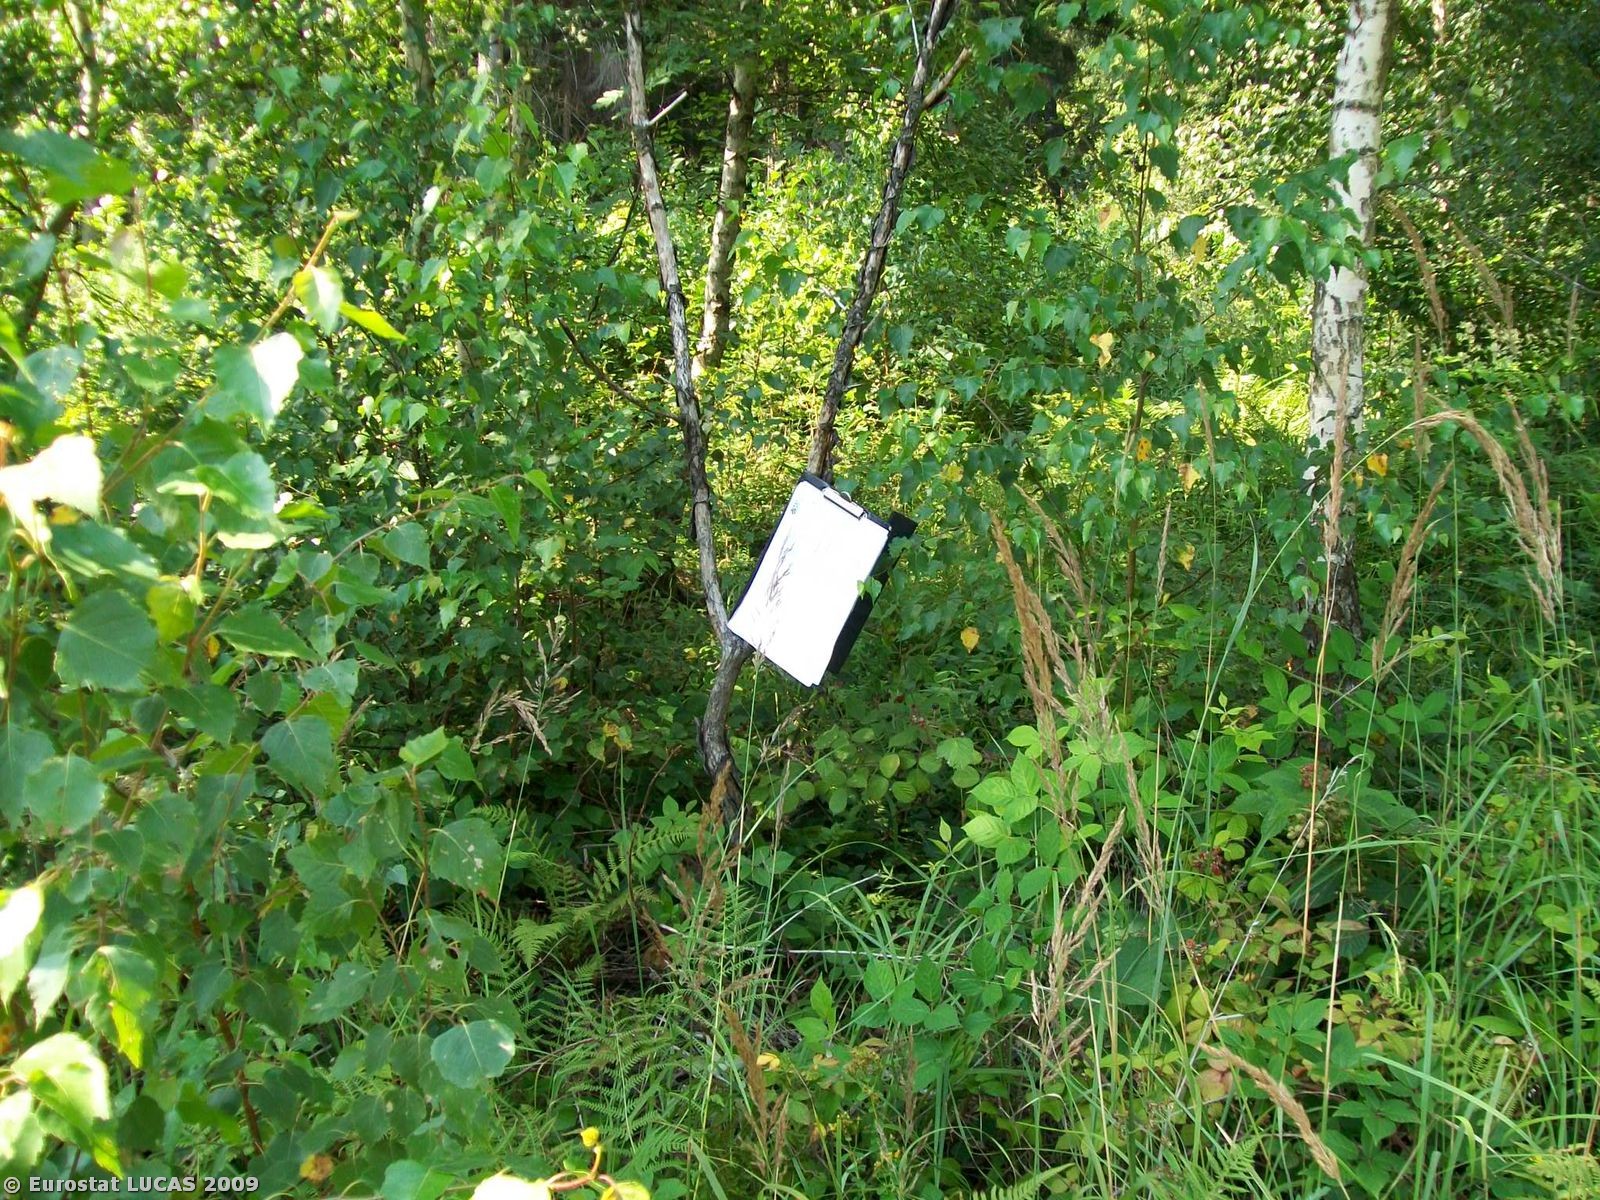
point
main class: Woodland
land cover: Mixed woodland
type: hemiboreal forest and nemoral coniferous forest and mixed broadleaved-coniferous forest
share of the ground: > 75 %
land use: Nature reserves
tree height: > 5 m
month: August
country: PL
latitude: 50.8516
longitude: 16.7275
